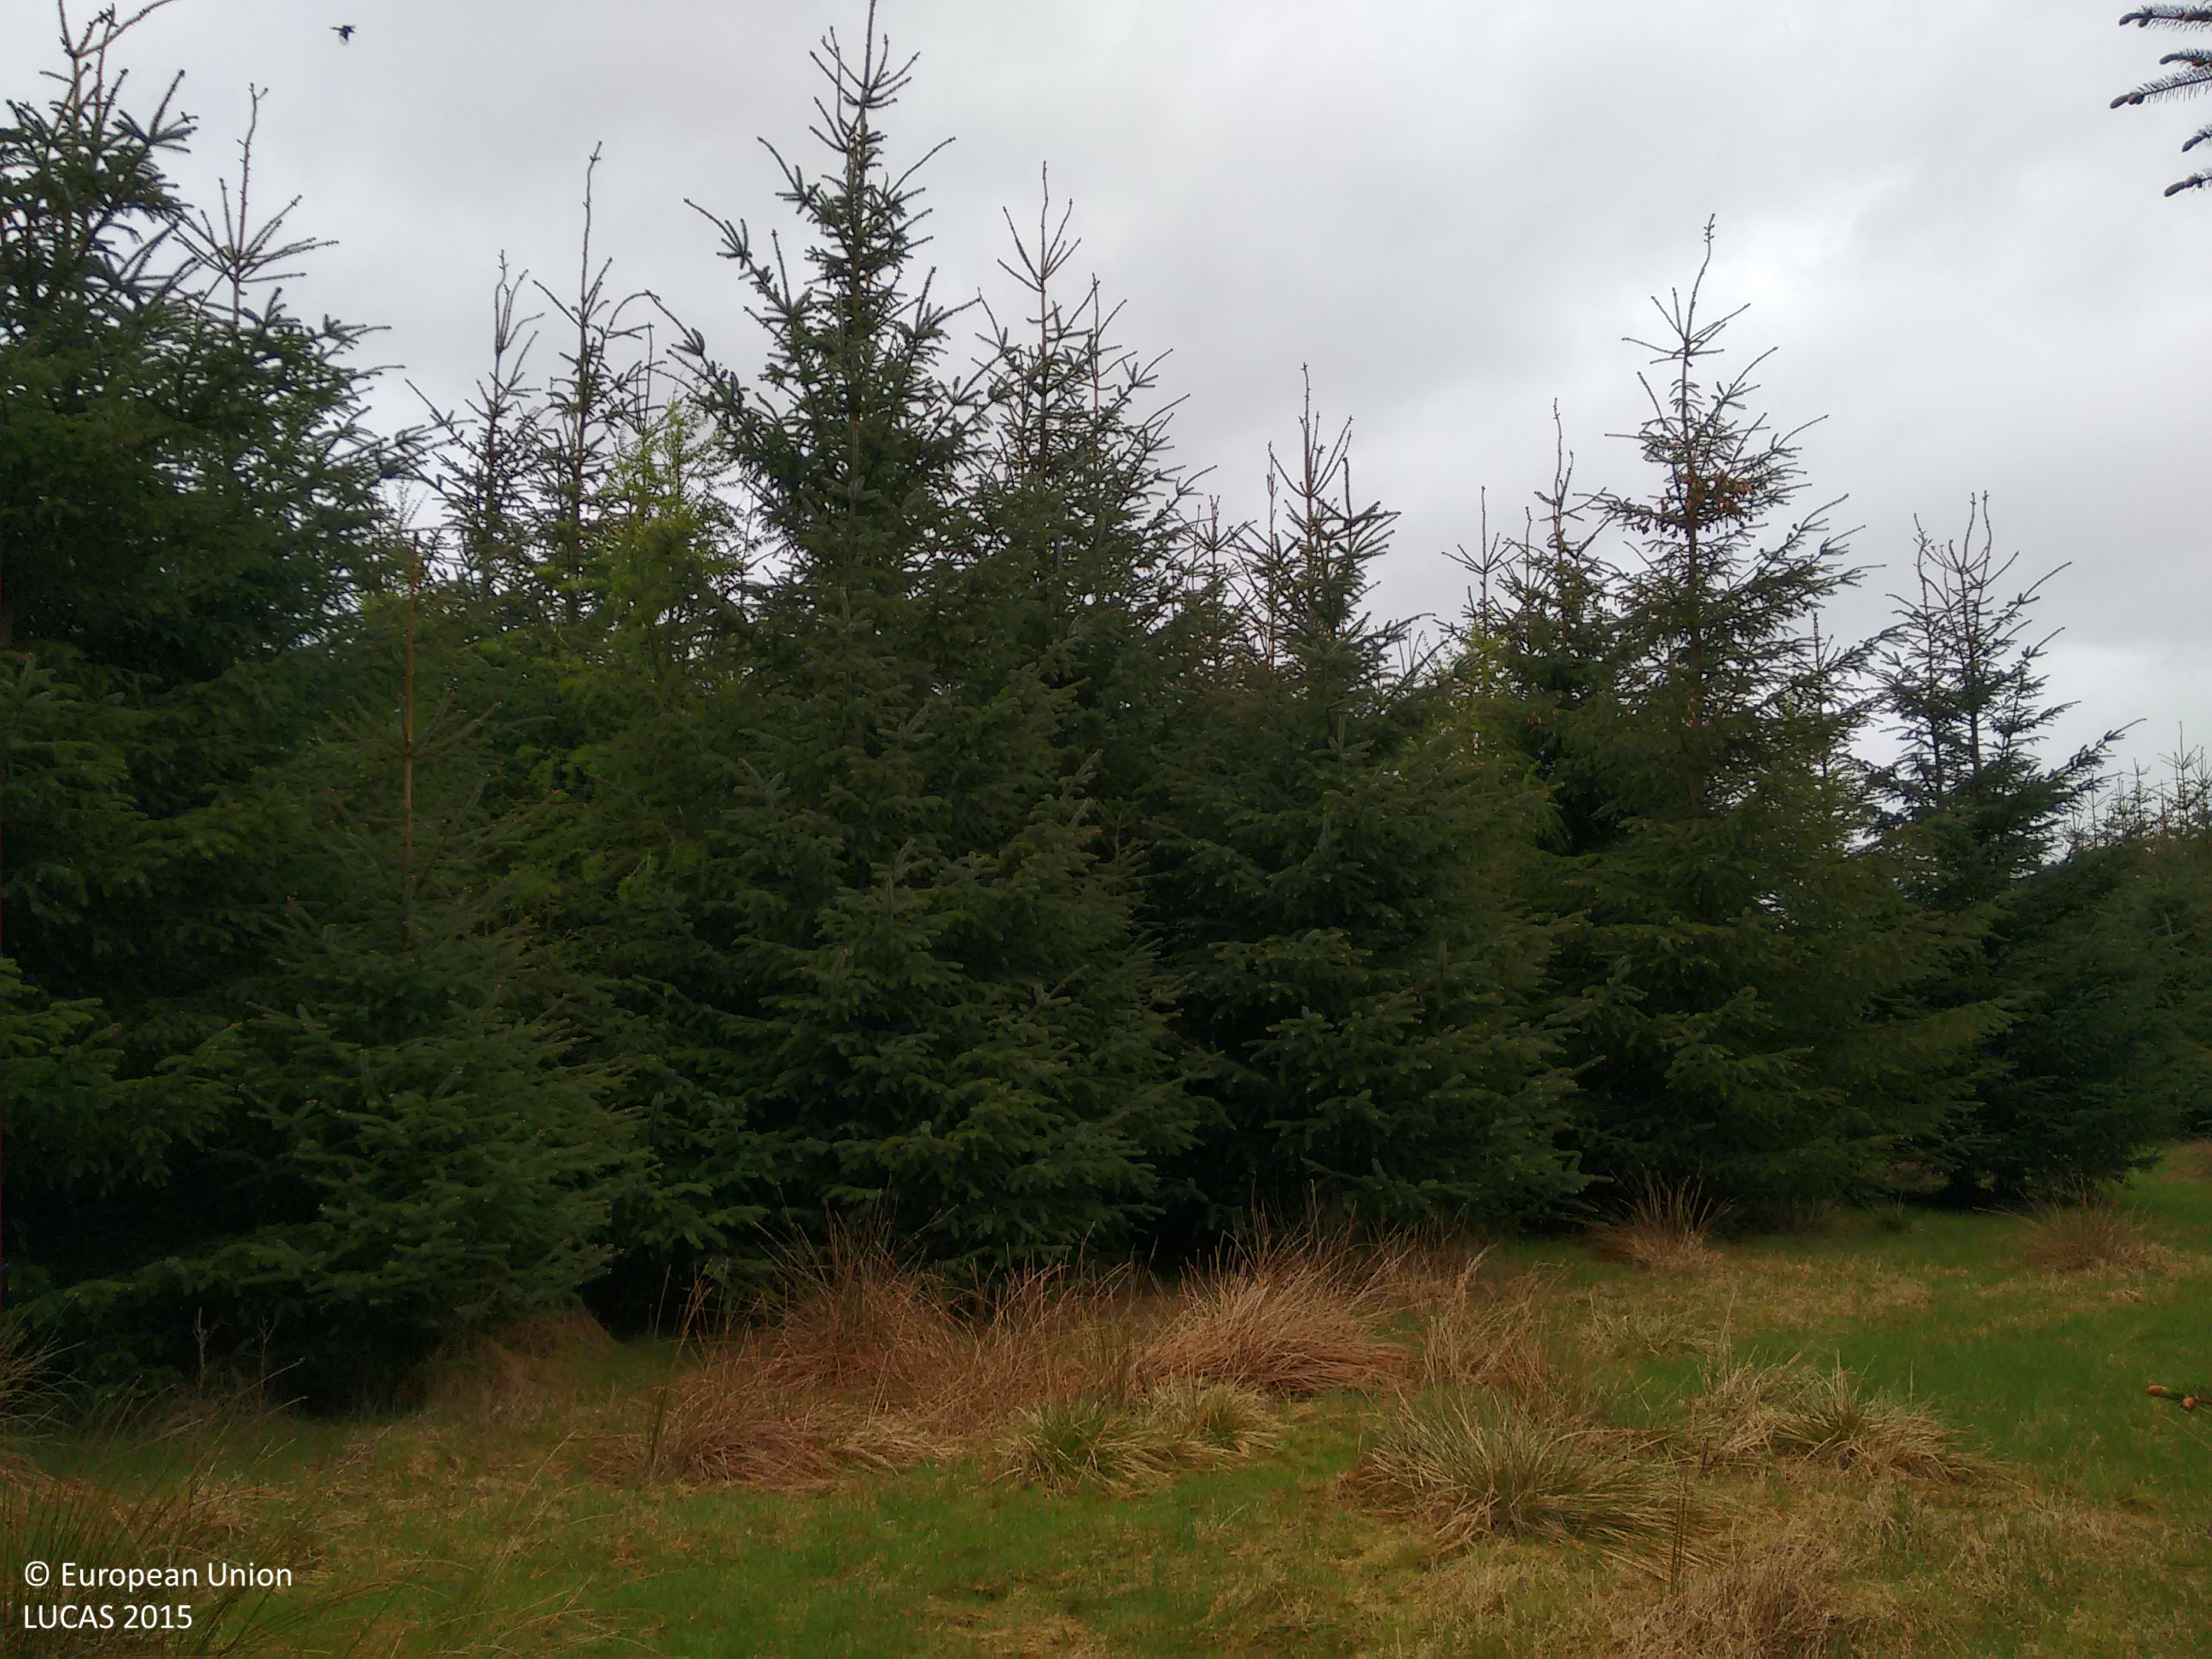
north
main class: Woodland
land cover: Spruce dominated coniferous woodland
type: hemiboreal forest and nemoral coniferous forest and mixed broadleaved-coniferous forest
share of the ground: > 75 %
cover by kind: coniferous forest trees 100 %
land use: Forestry
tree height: > 5 m
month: May
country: GB
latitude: 55.9167
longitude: -3.9263
